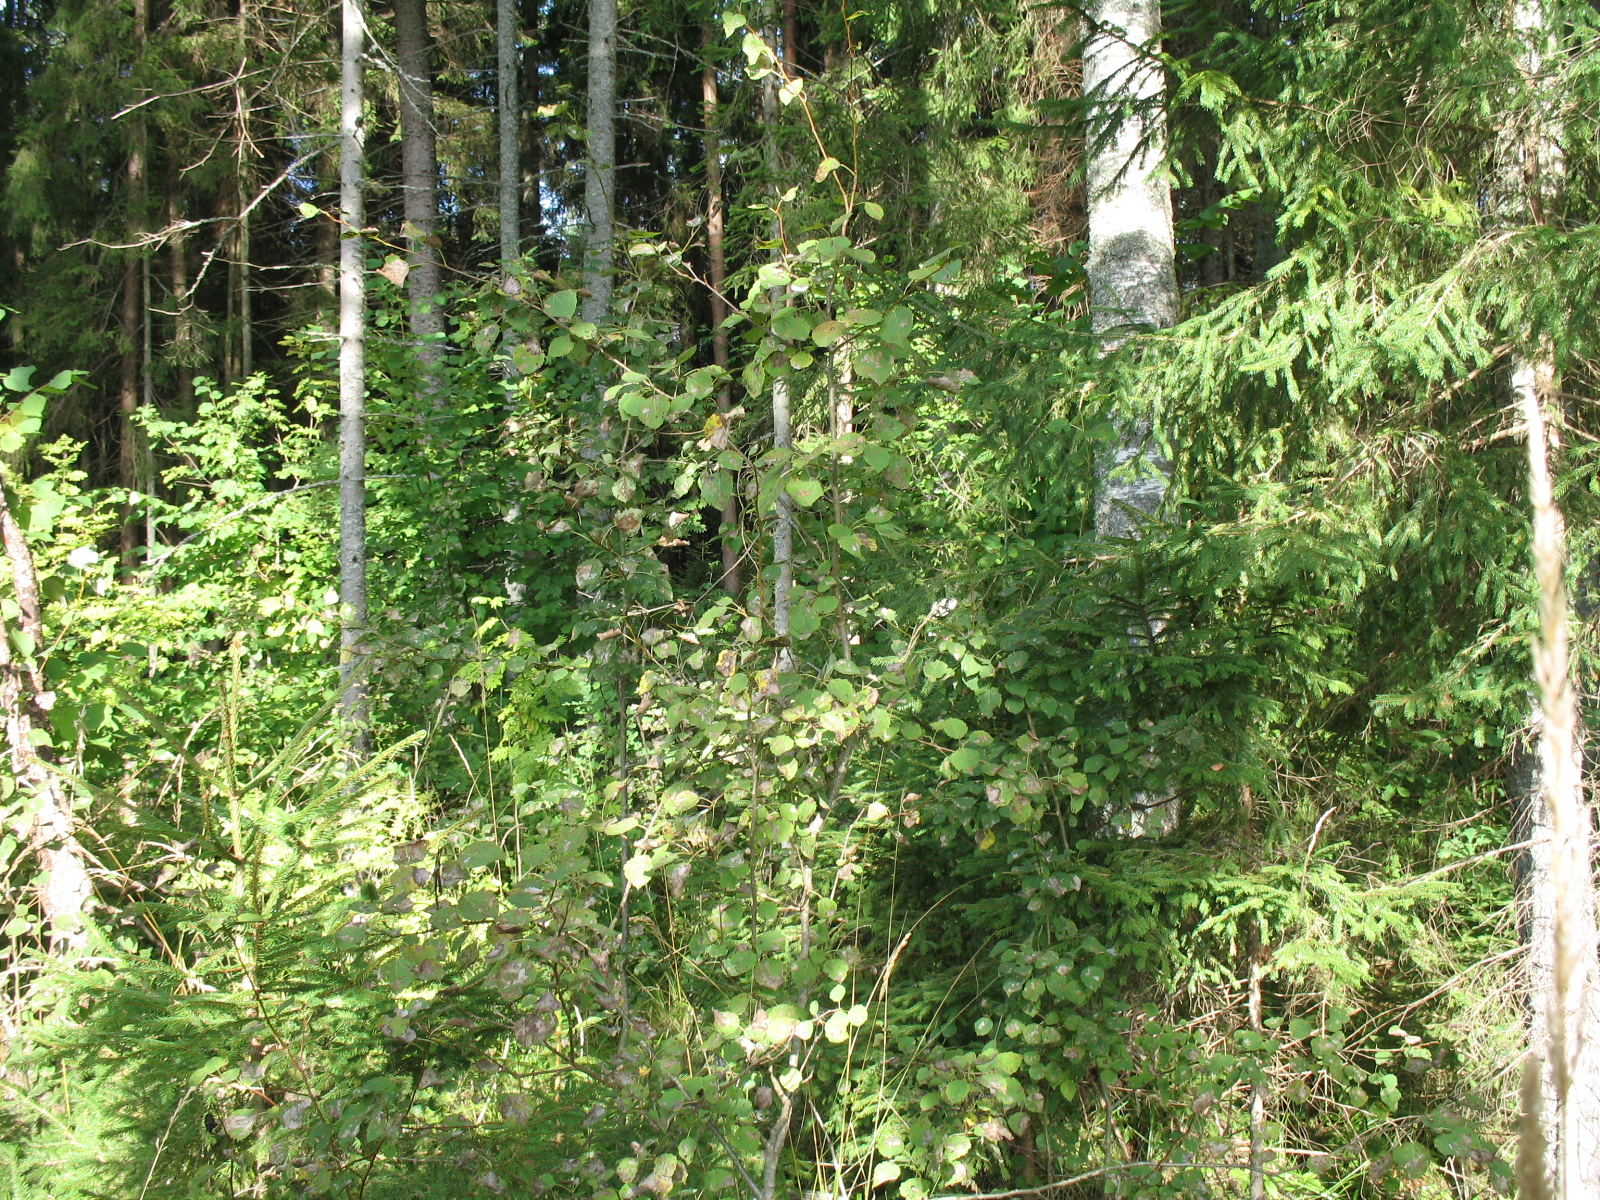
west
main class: Woodland
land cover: Spruce dominated mixed woodland
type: hemiboreal forest and nemoral coniferous forest and mixed broadleaved-coniferous forest
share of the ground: 50 - 75 %
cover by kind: coniferous forest trees 40 %, broadleaved forest trees 30 %, shrubs 20 %, herbaceous plants 10 %
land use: Forestry
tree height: > 5 m
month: August
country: LV
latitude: 56.3666
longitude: 26.0155
